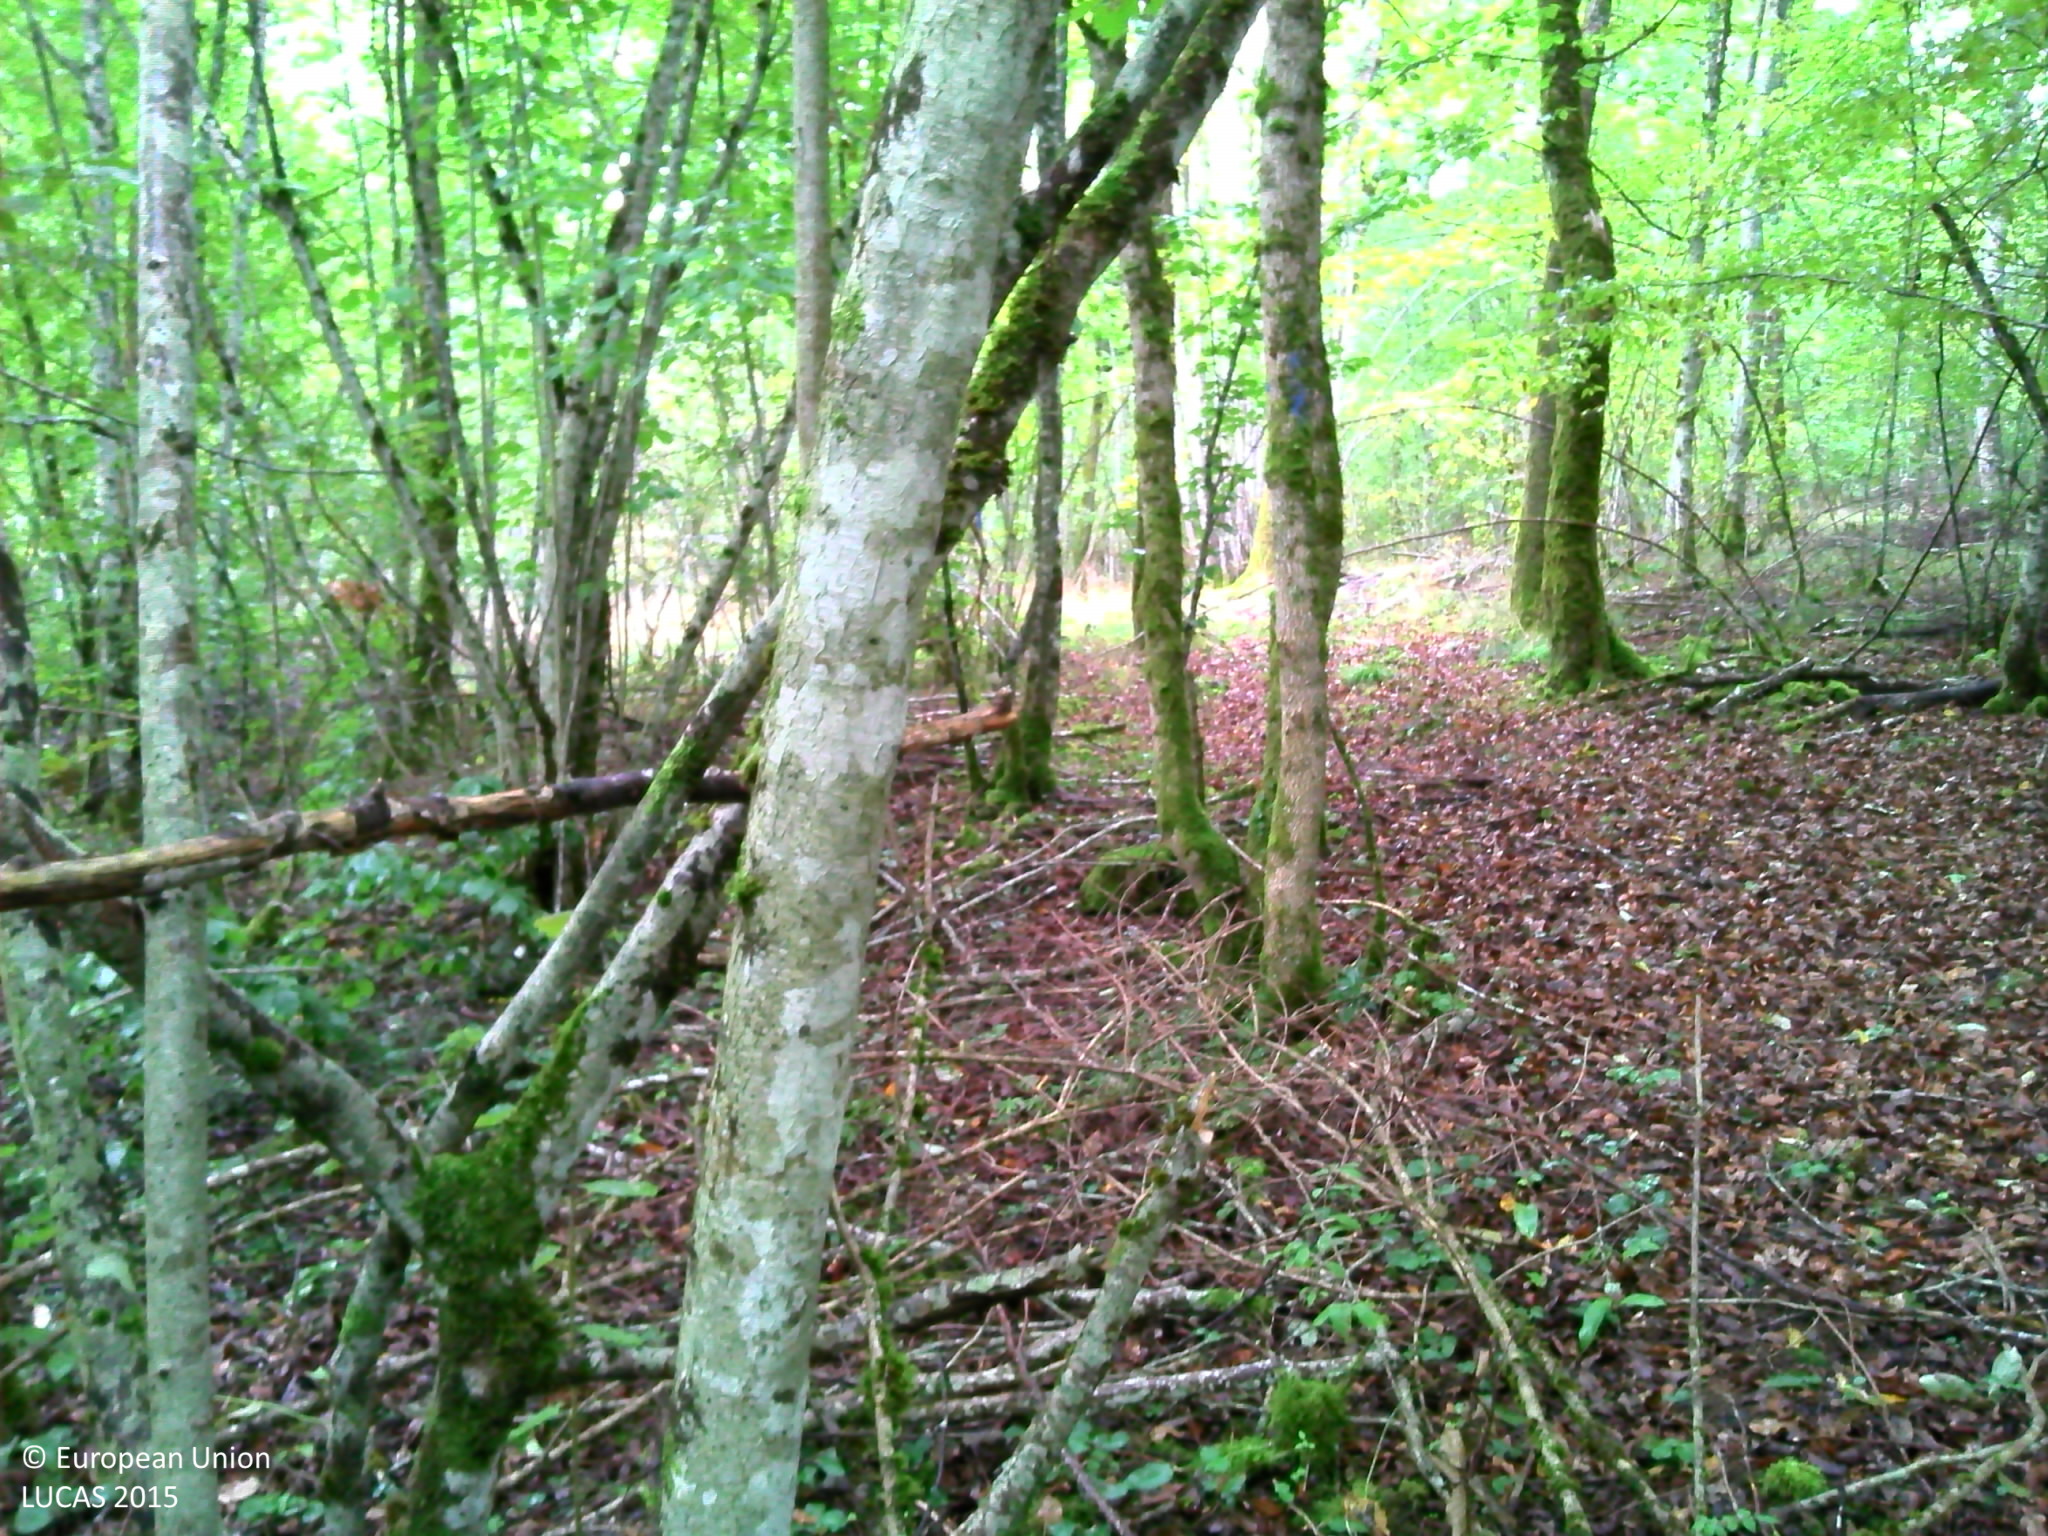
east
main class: Woodland
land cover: Broadleaved woodland
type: mesophytic deciduous forest
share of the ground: > 75 %
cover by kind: broadleaved forest trees 80 %, herbaceous plants 15 %, shrubs 5 %
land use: Forestry
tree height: > 5 m
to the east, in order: Broadleaved woodland; Tracks; Broadleaved woodland
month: September
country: FR
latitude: 47.1266
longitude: 4.7935
